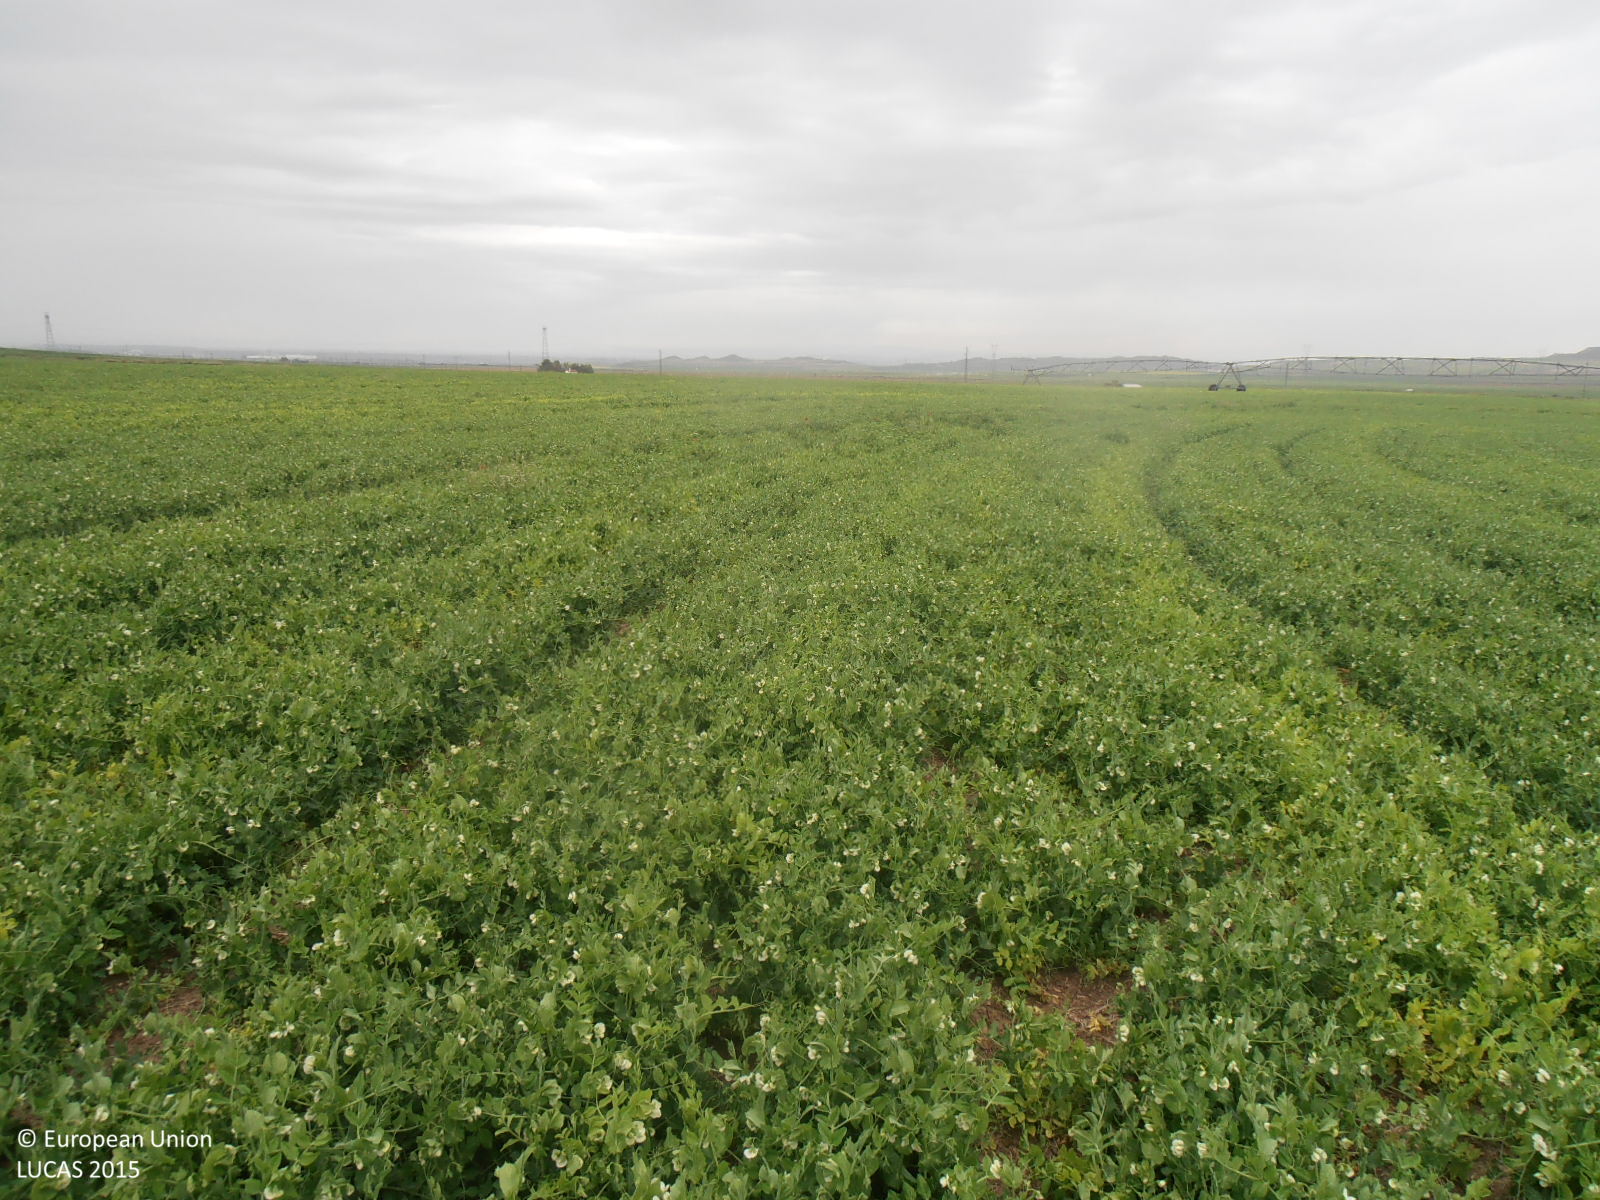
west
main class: Cropland
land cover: Dry pulses
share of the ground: > 75 %
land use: Agriculture (excluding fallow land and kitchen gardens)
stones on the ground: < 10 %
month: April
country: ES
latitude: 41.4445
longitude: -0.3938
